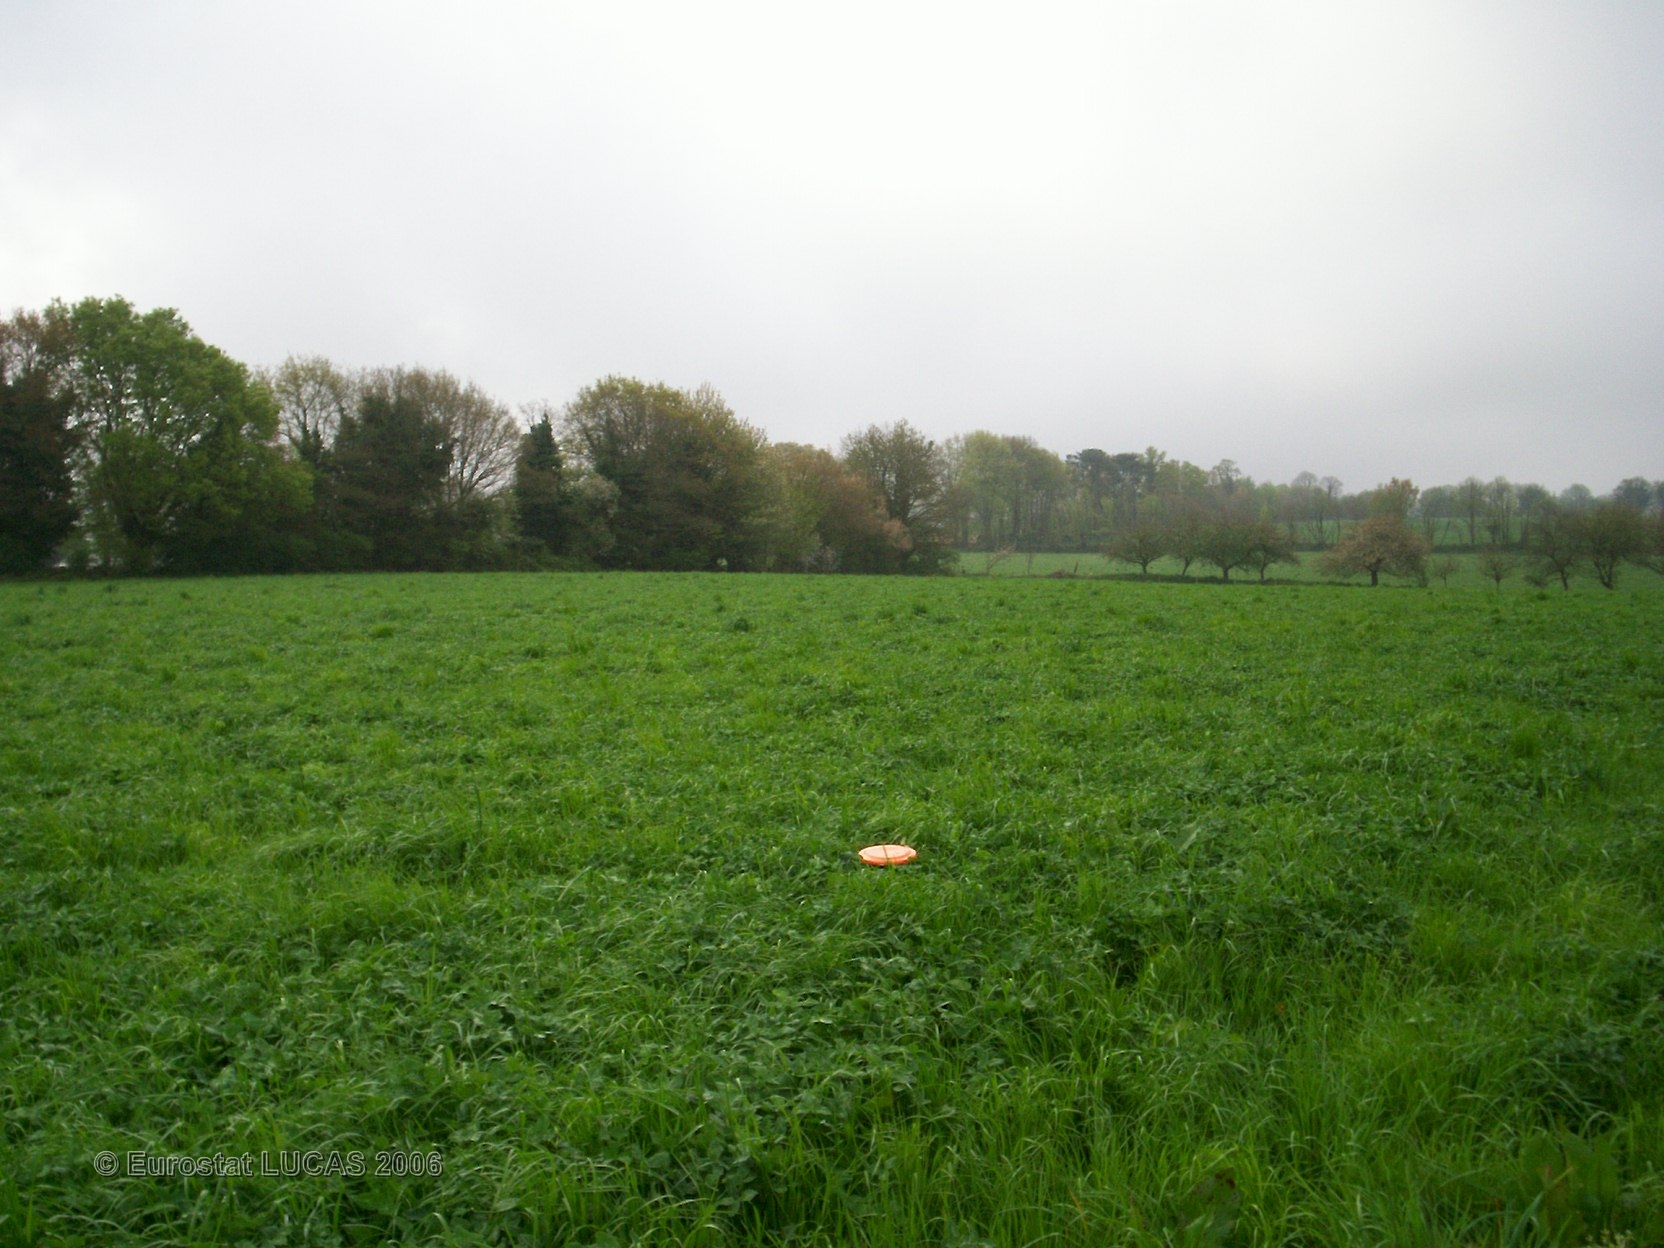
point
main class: Grassland
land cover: Grassland without tree/shrub cover
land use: Agriculture (excluding fallow land and kitchen gardens)
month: May
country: FR
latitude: 47.7646
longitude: -2.8050
